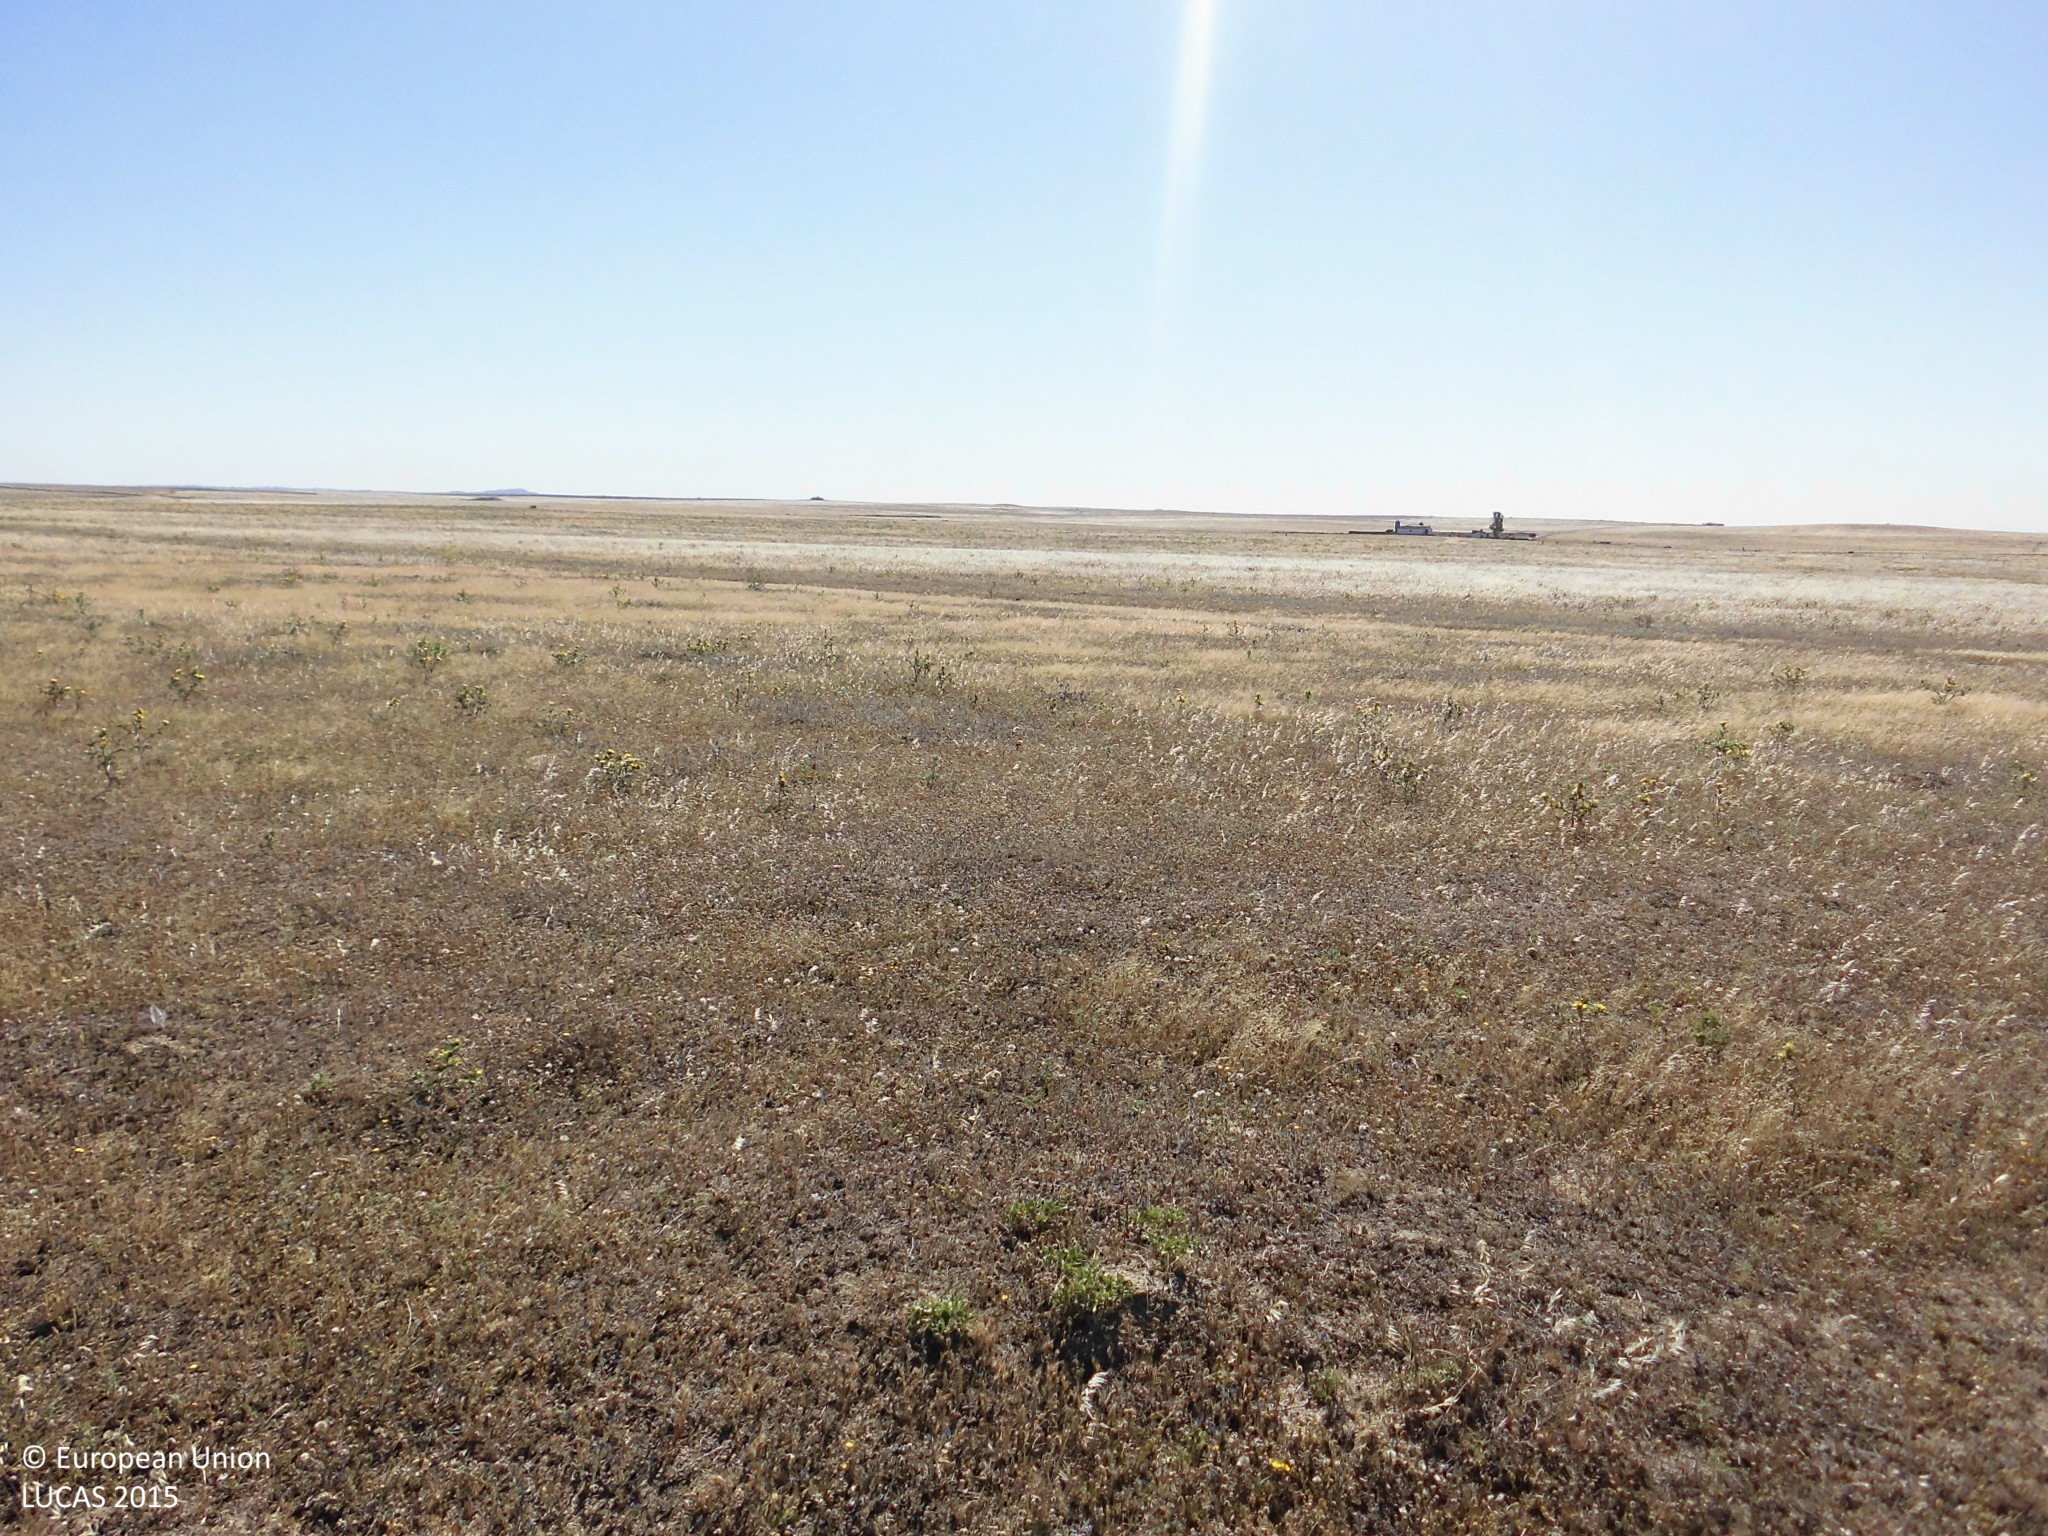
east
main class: Grassland
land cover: Grassland without tree/shrub cover
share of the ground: > 75 %
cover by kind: herbaceous plants 100 %
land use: Agriculture (excluding fallow land and kitchen gardens)
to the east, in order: Grassland without tree/shrub cover; Tracks; Grassland without tree/shrub cover
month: May
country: ES
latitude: 39.5364
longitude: -6.8450
